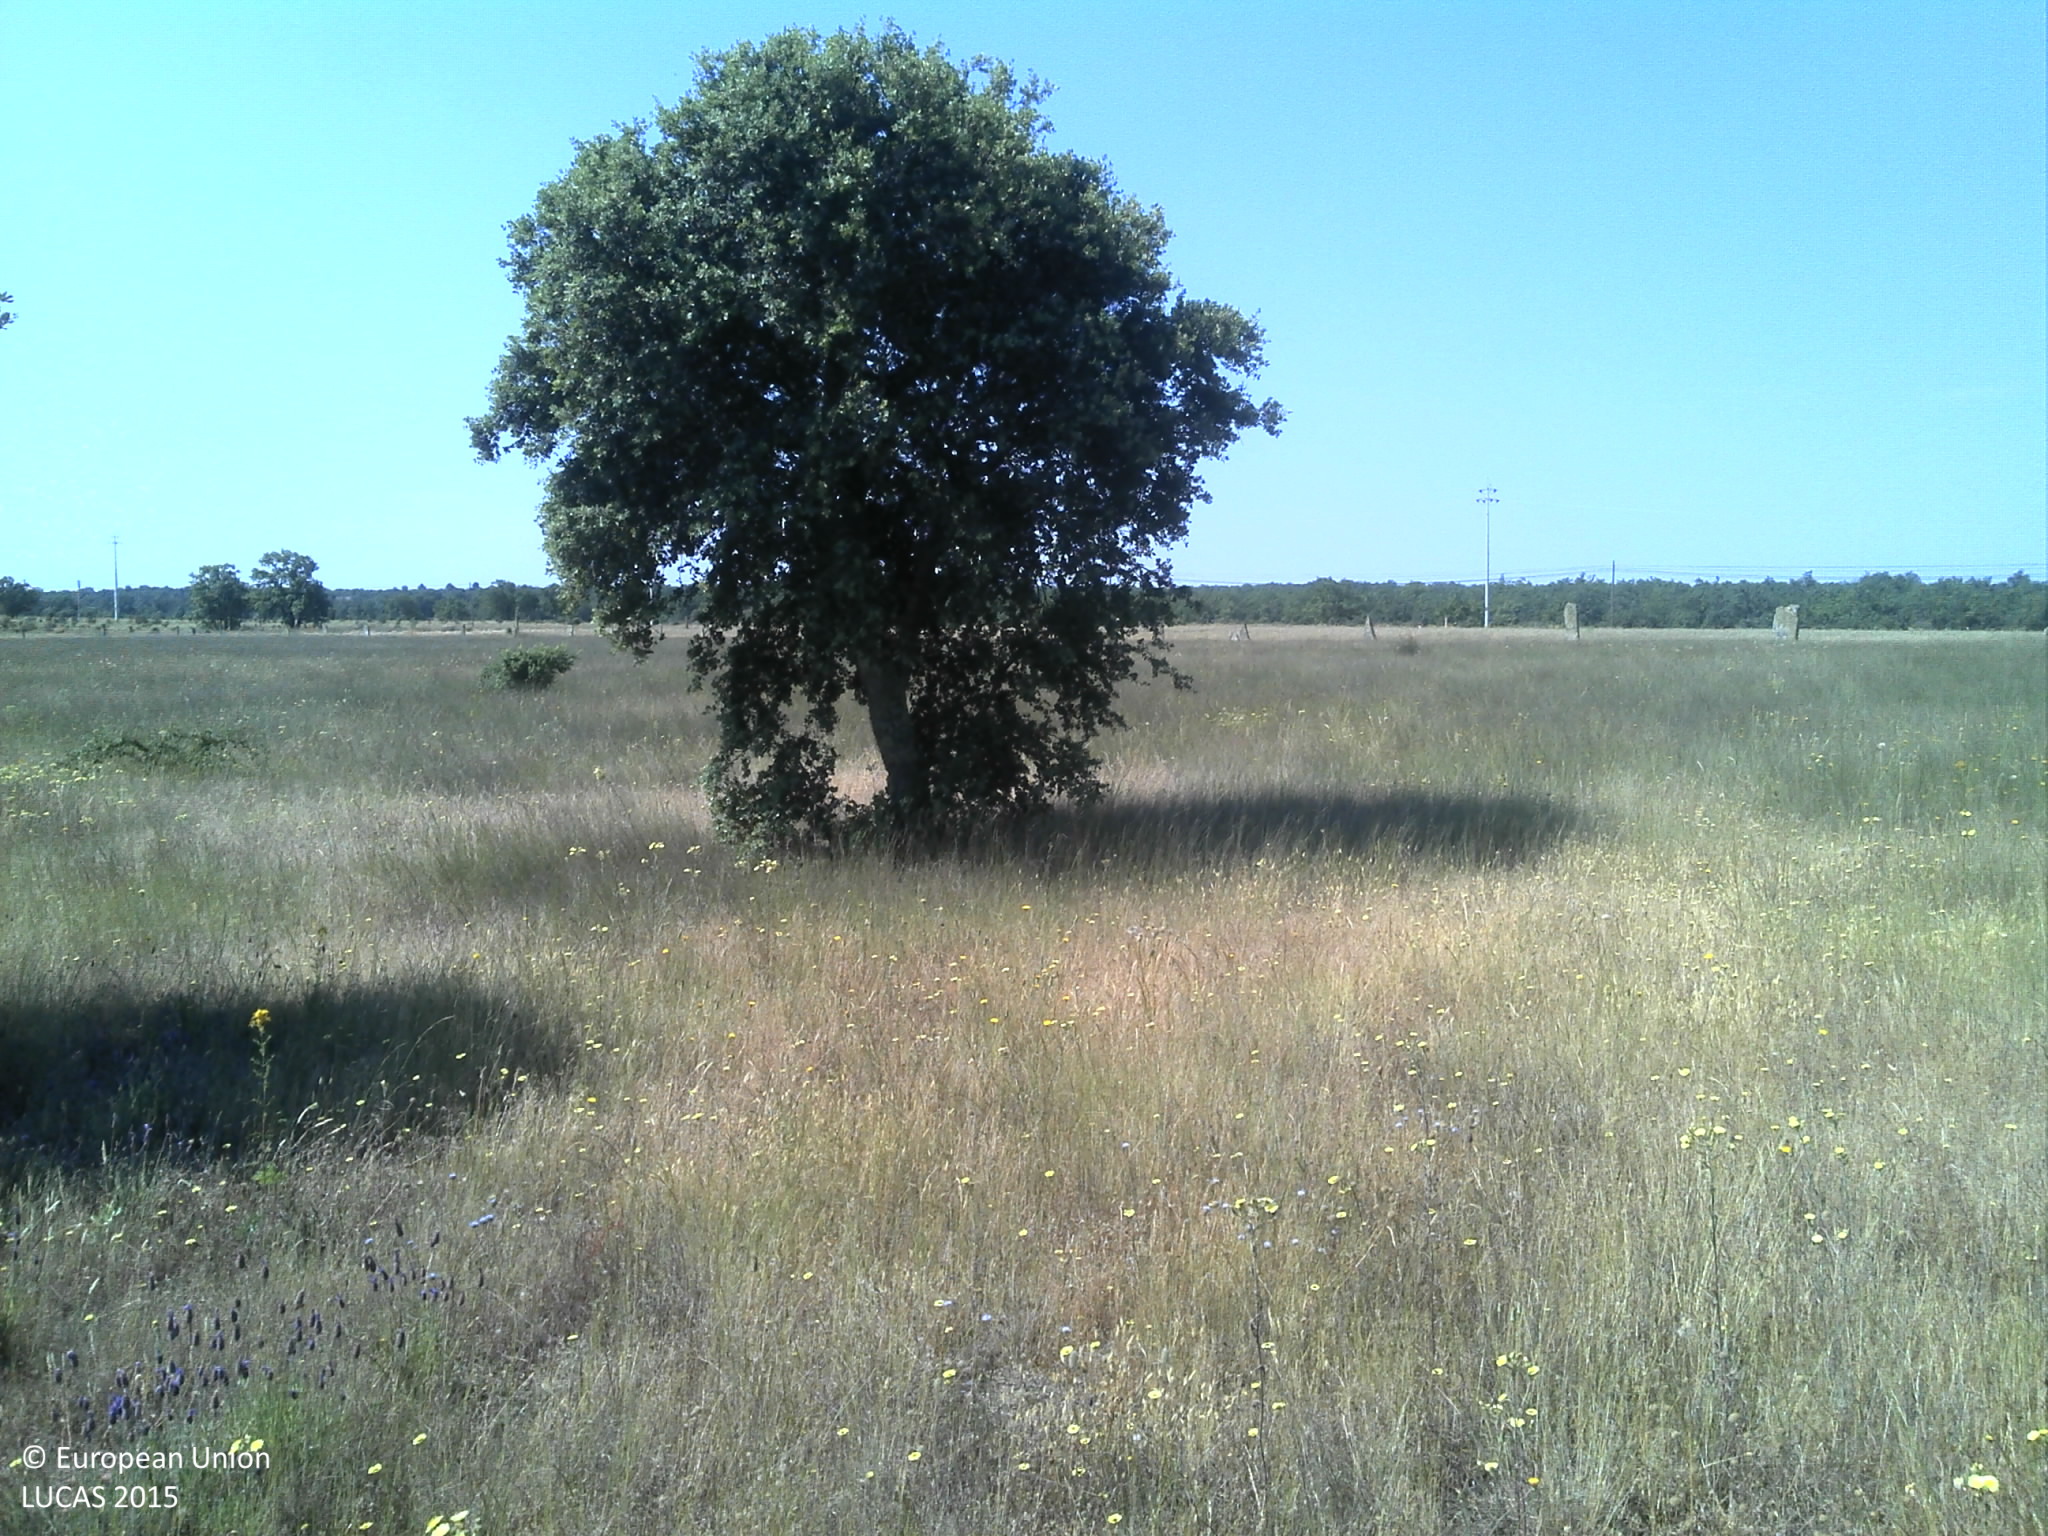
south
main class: Grassland
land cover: Grassland with sparse tree/shrub cover
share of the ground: 50 - 75 %
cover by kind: herbaceous plants 60 %, unconsolidated bare surface 30 %, broadleaved forest trees 5 %
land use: Agriculture (excluding fallow land and kitchen gardens)
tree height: > 5 m
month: June
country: PT
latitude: 40.5310
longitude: -6.8474
